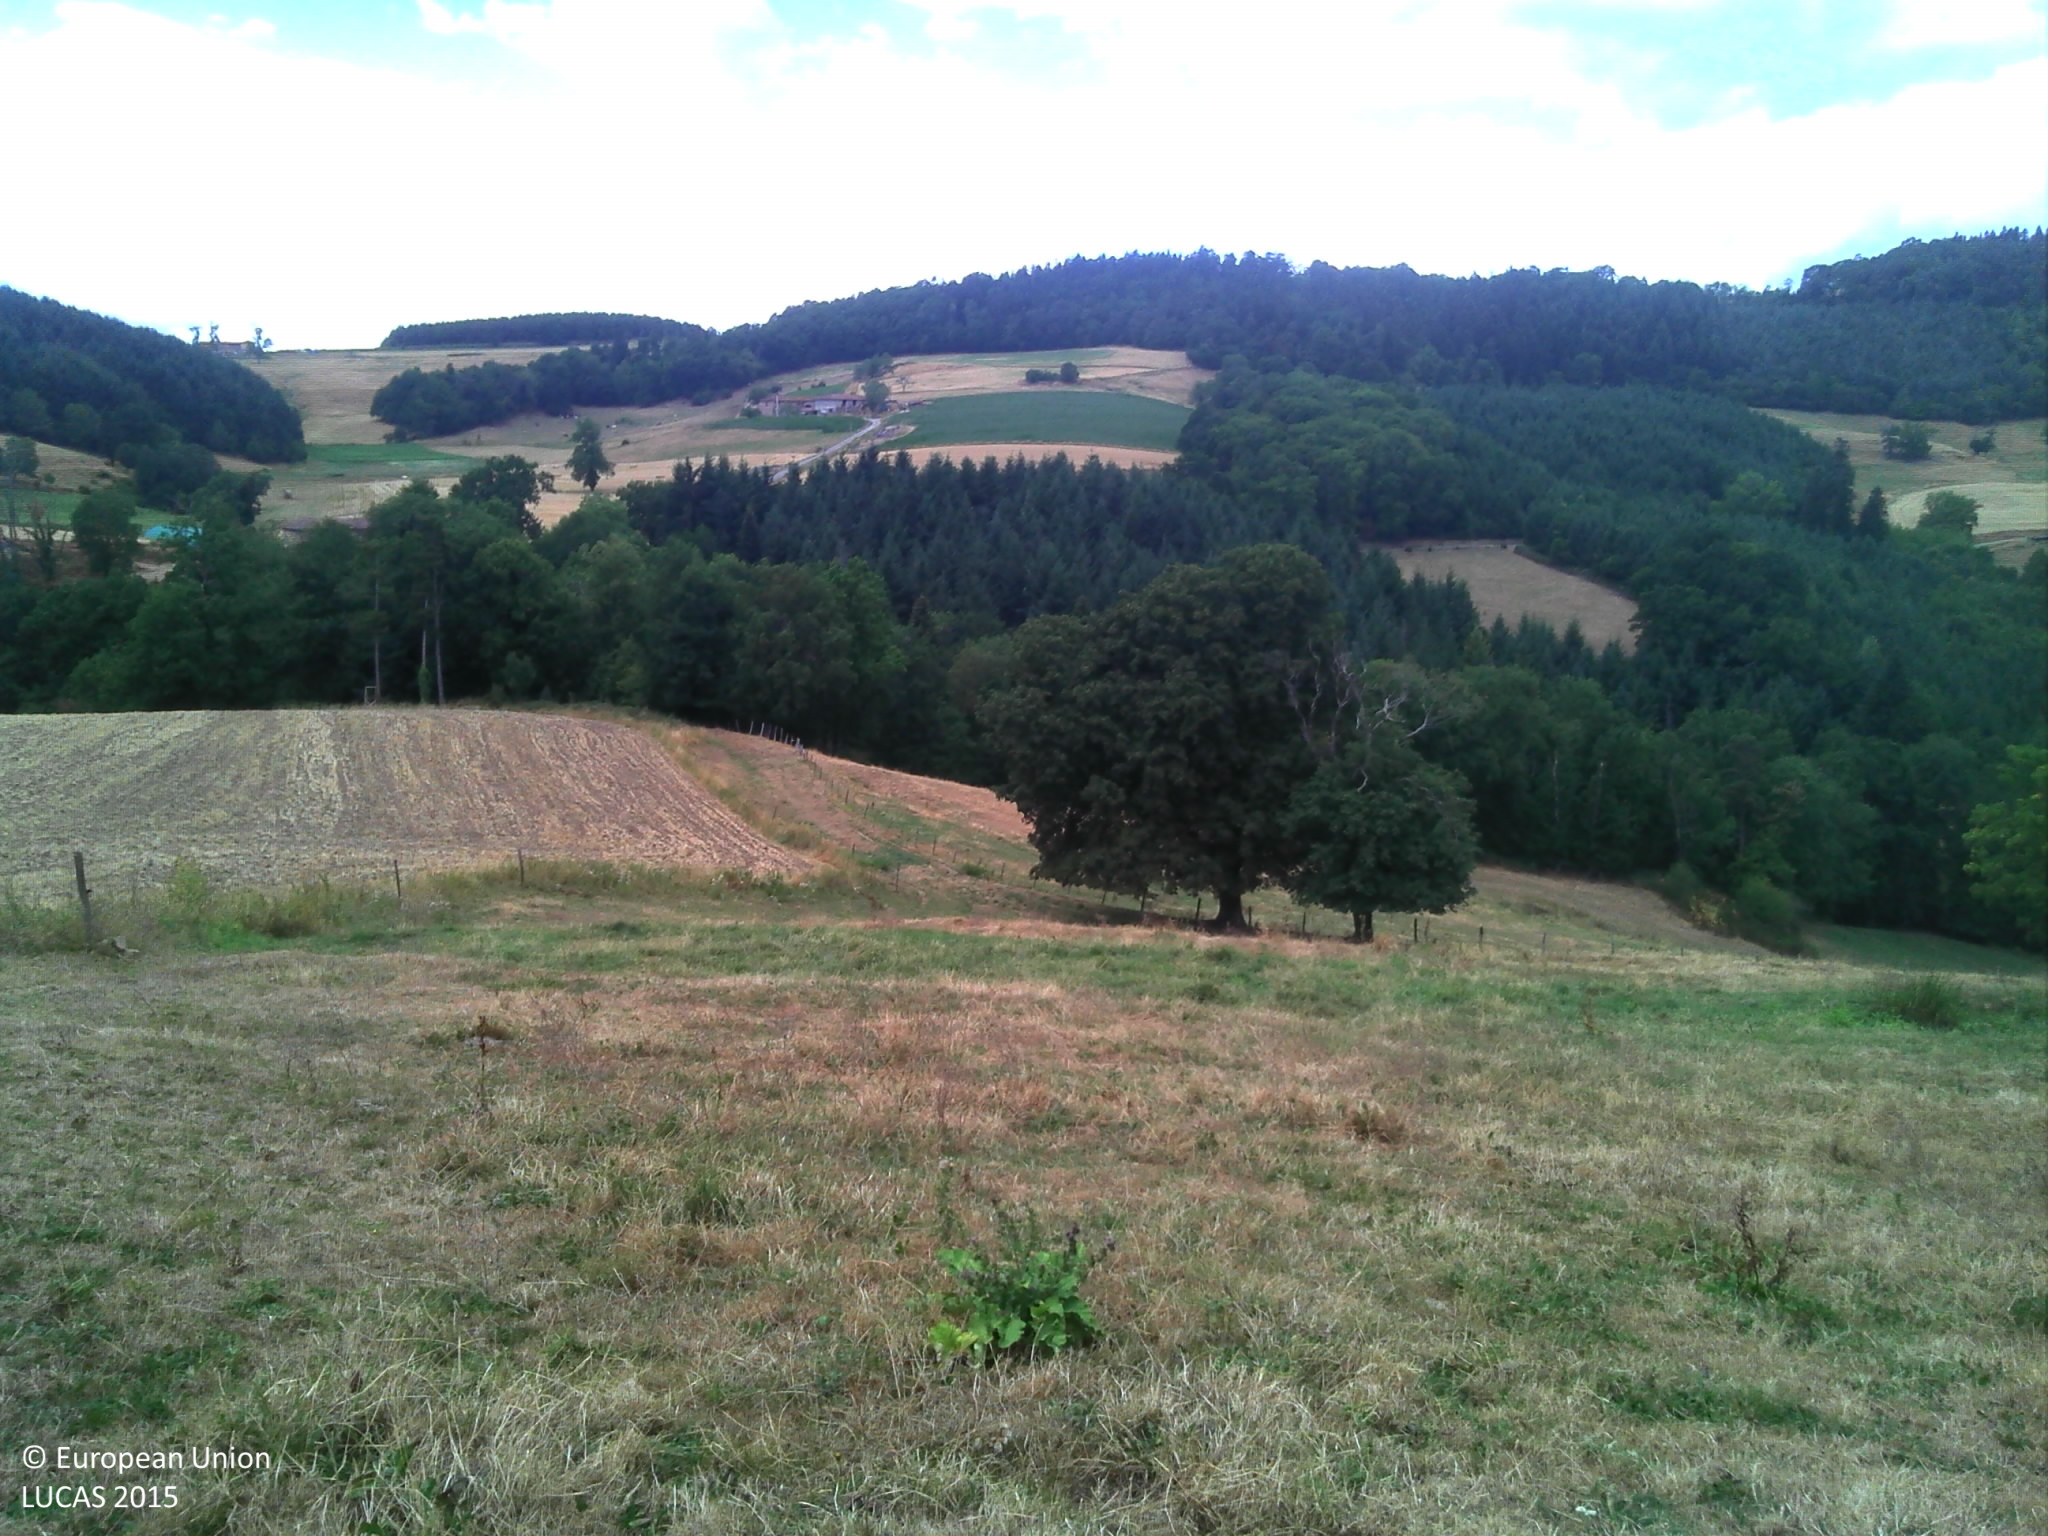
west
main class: Grassland
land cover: Grassland without tree/shrub cover
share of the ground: > 75 %
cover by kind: herbaceous plants 100 %
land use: Agriculture (excluding fallow land and kitchen gardens)
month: July
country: FR
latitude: 45.7564
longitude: 4.4621
